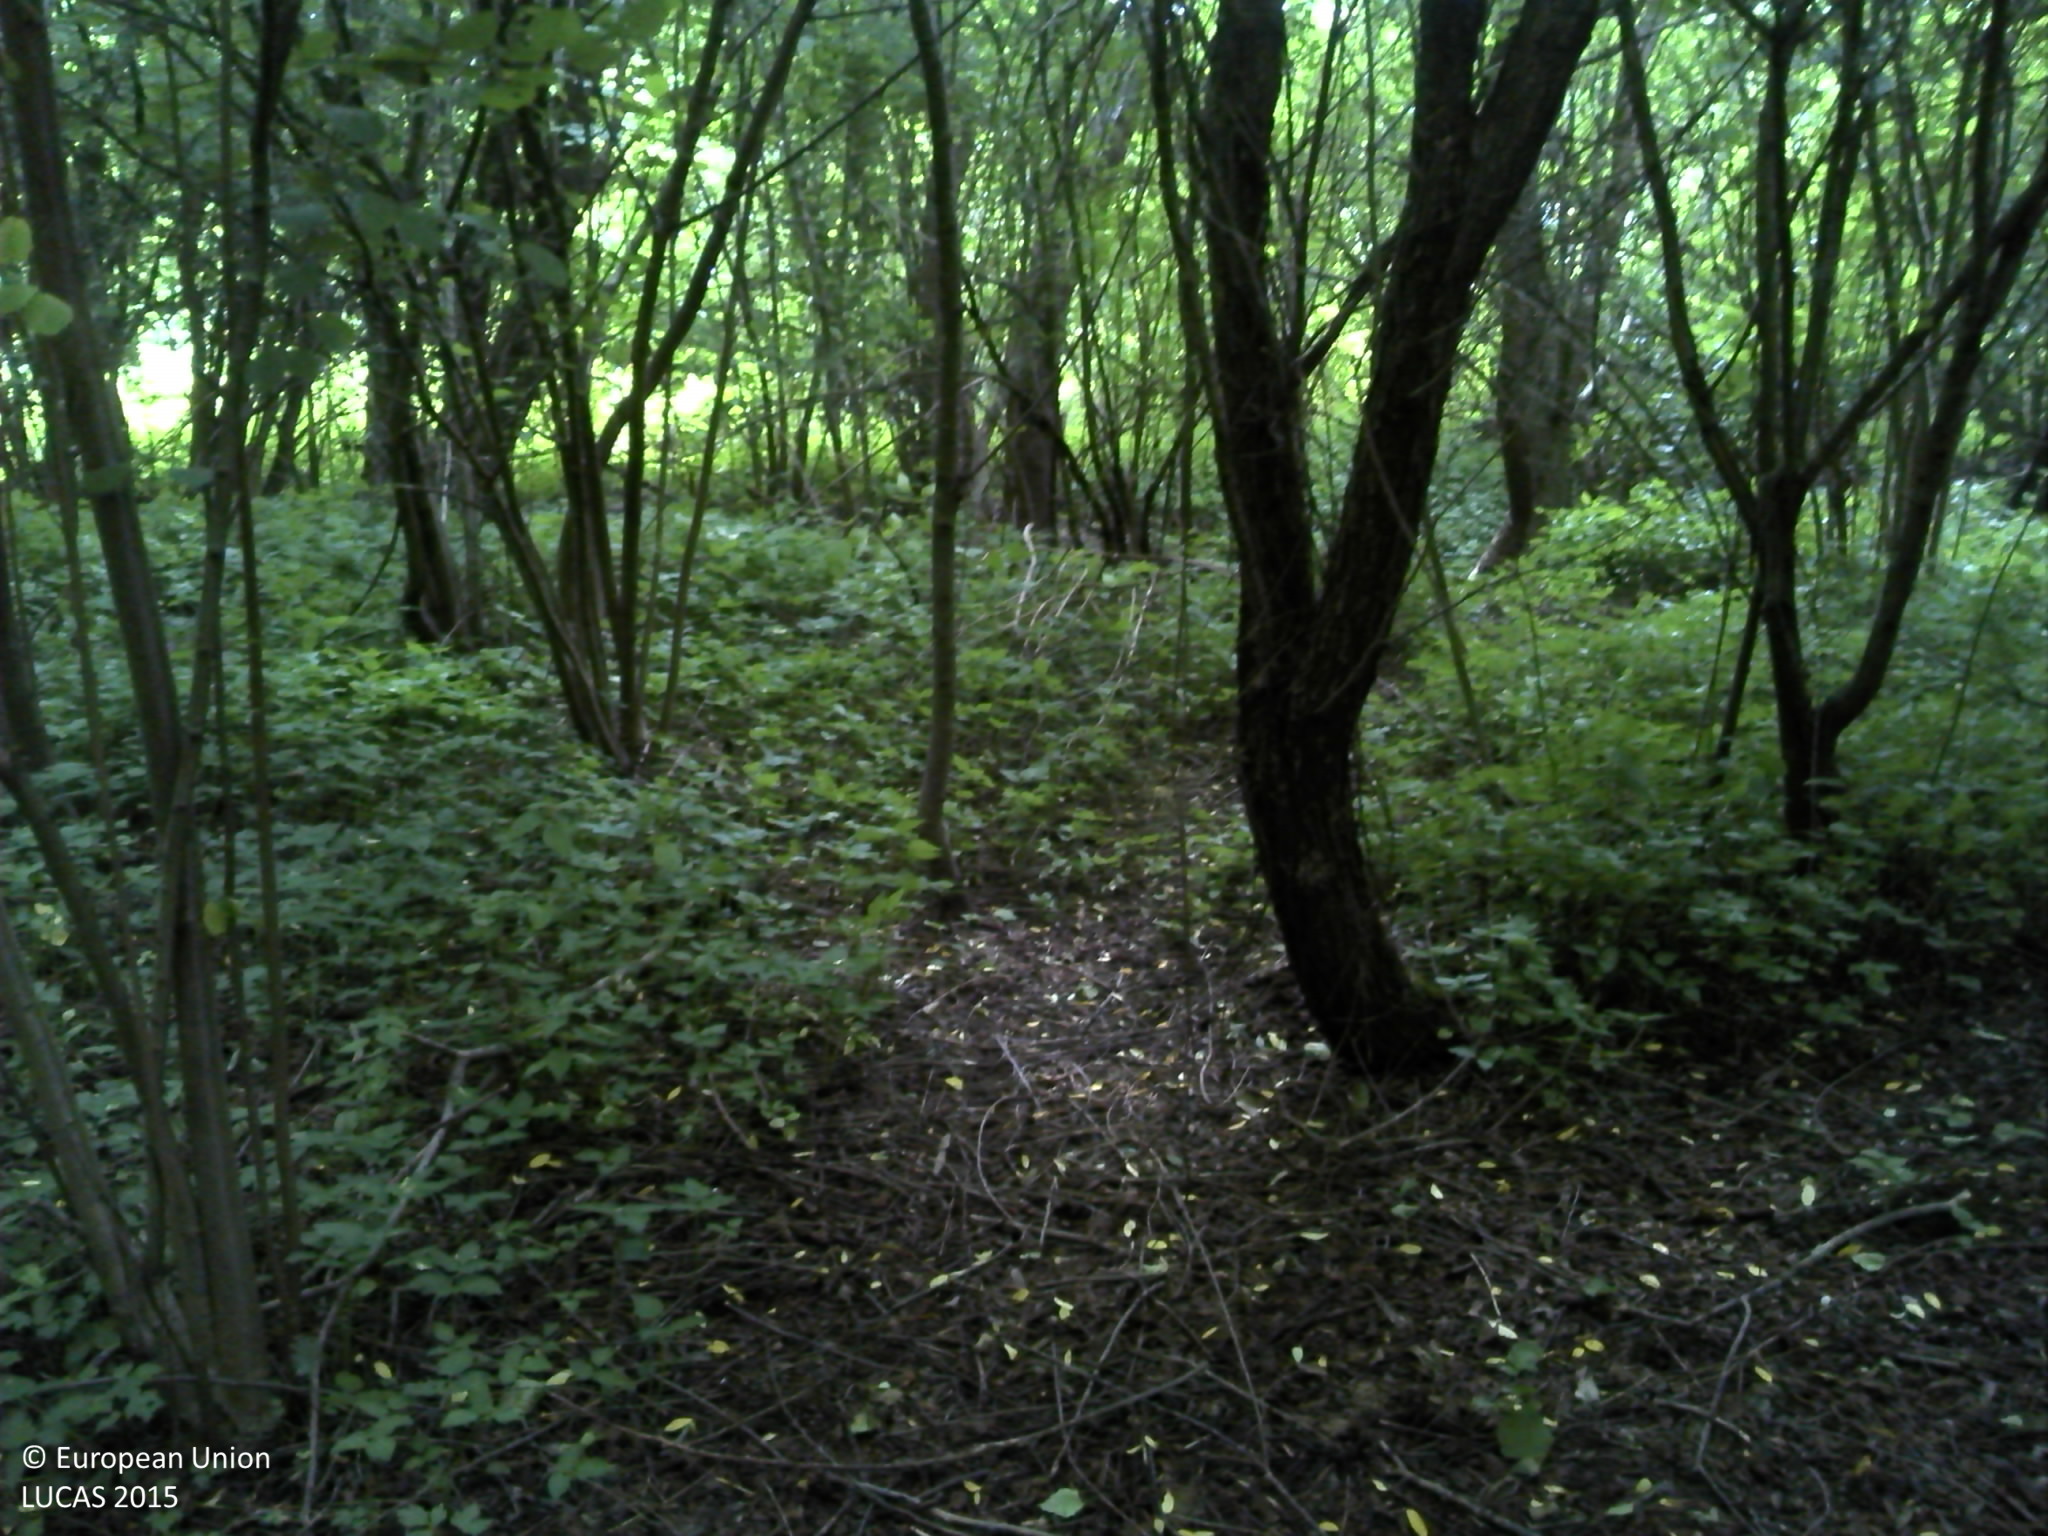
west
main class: Woodland
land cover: Broadleaved woodland
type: acidophilous oak and oak-birch forest
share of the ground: > 75 %
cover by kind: broadleaved forest trees 100 %
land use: Forestry
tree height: > 5 m
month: June
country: HR
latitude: 45.3122
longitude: 17.2065
